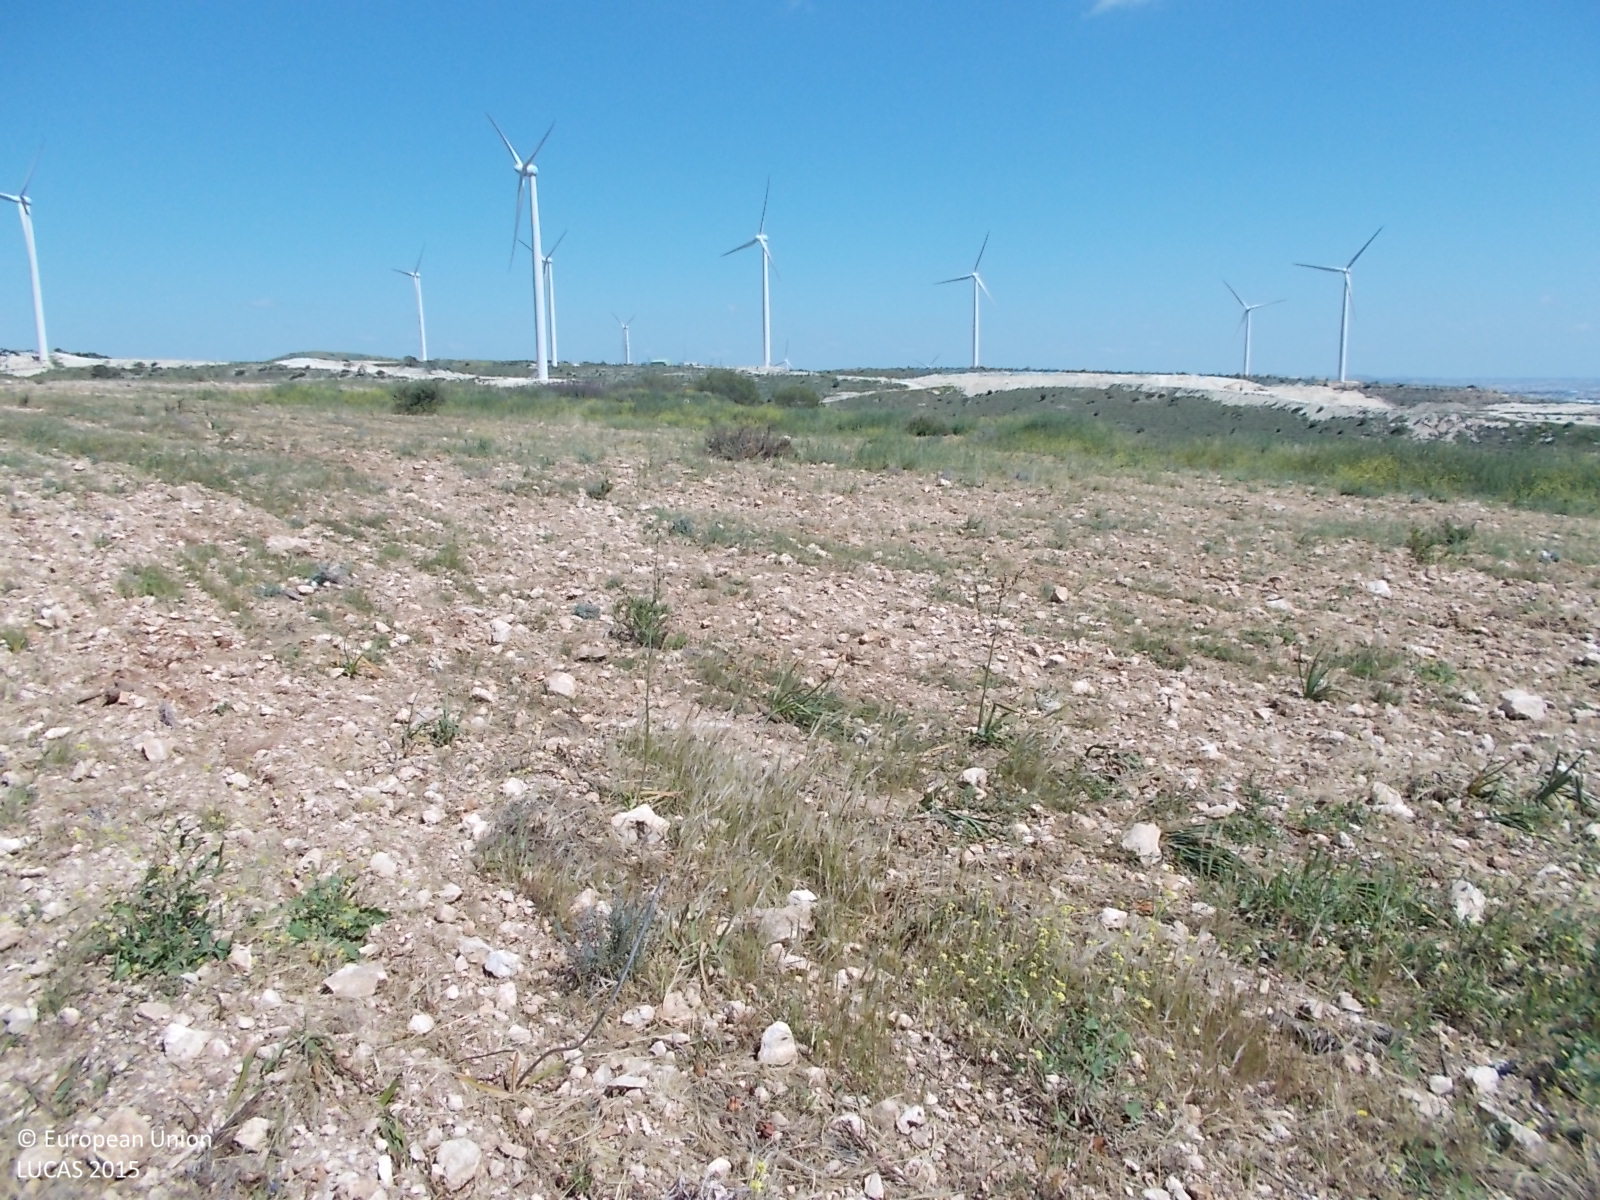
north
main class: Shrubland
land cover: Shrubland without tree cover
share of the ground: 10 - 25 %
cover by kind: unconsolidated bare surface 55 %, herbaceous plants 25 %, shrubs 20 %
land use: Energy production
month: April
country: CY
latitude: 34.8651
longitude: 33.5228
